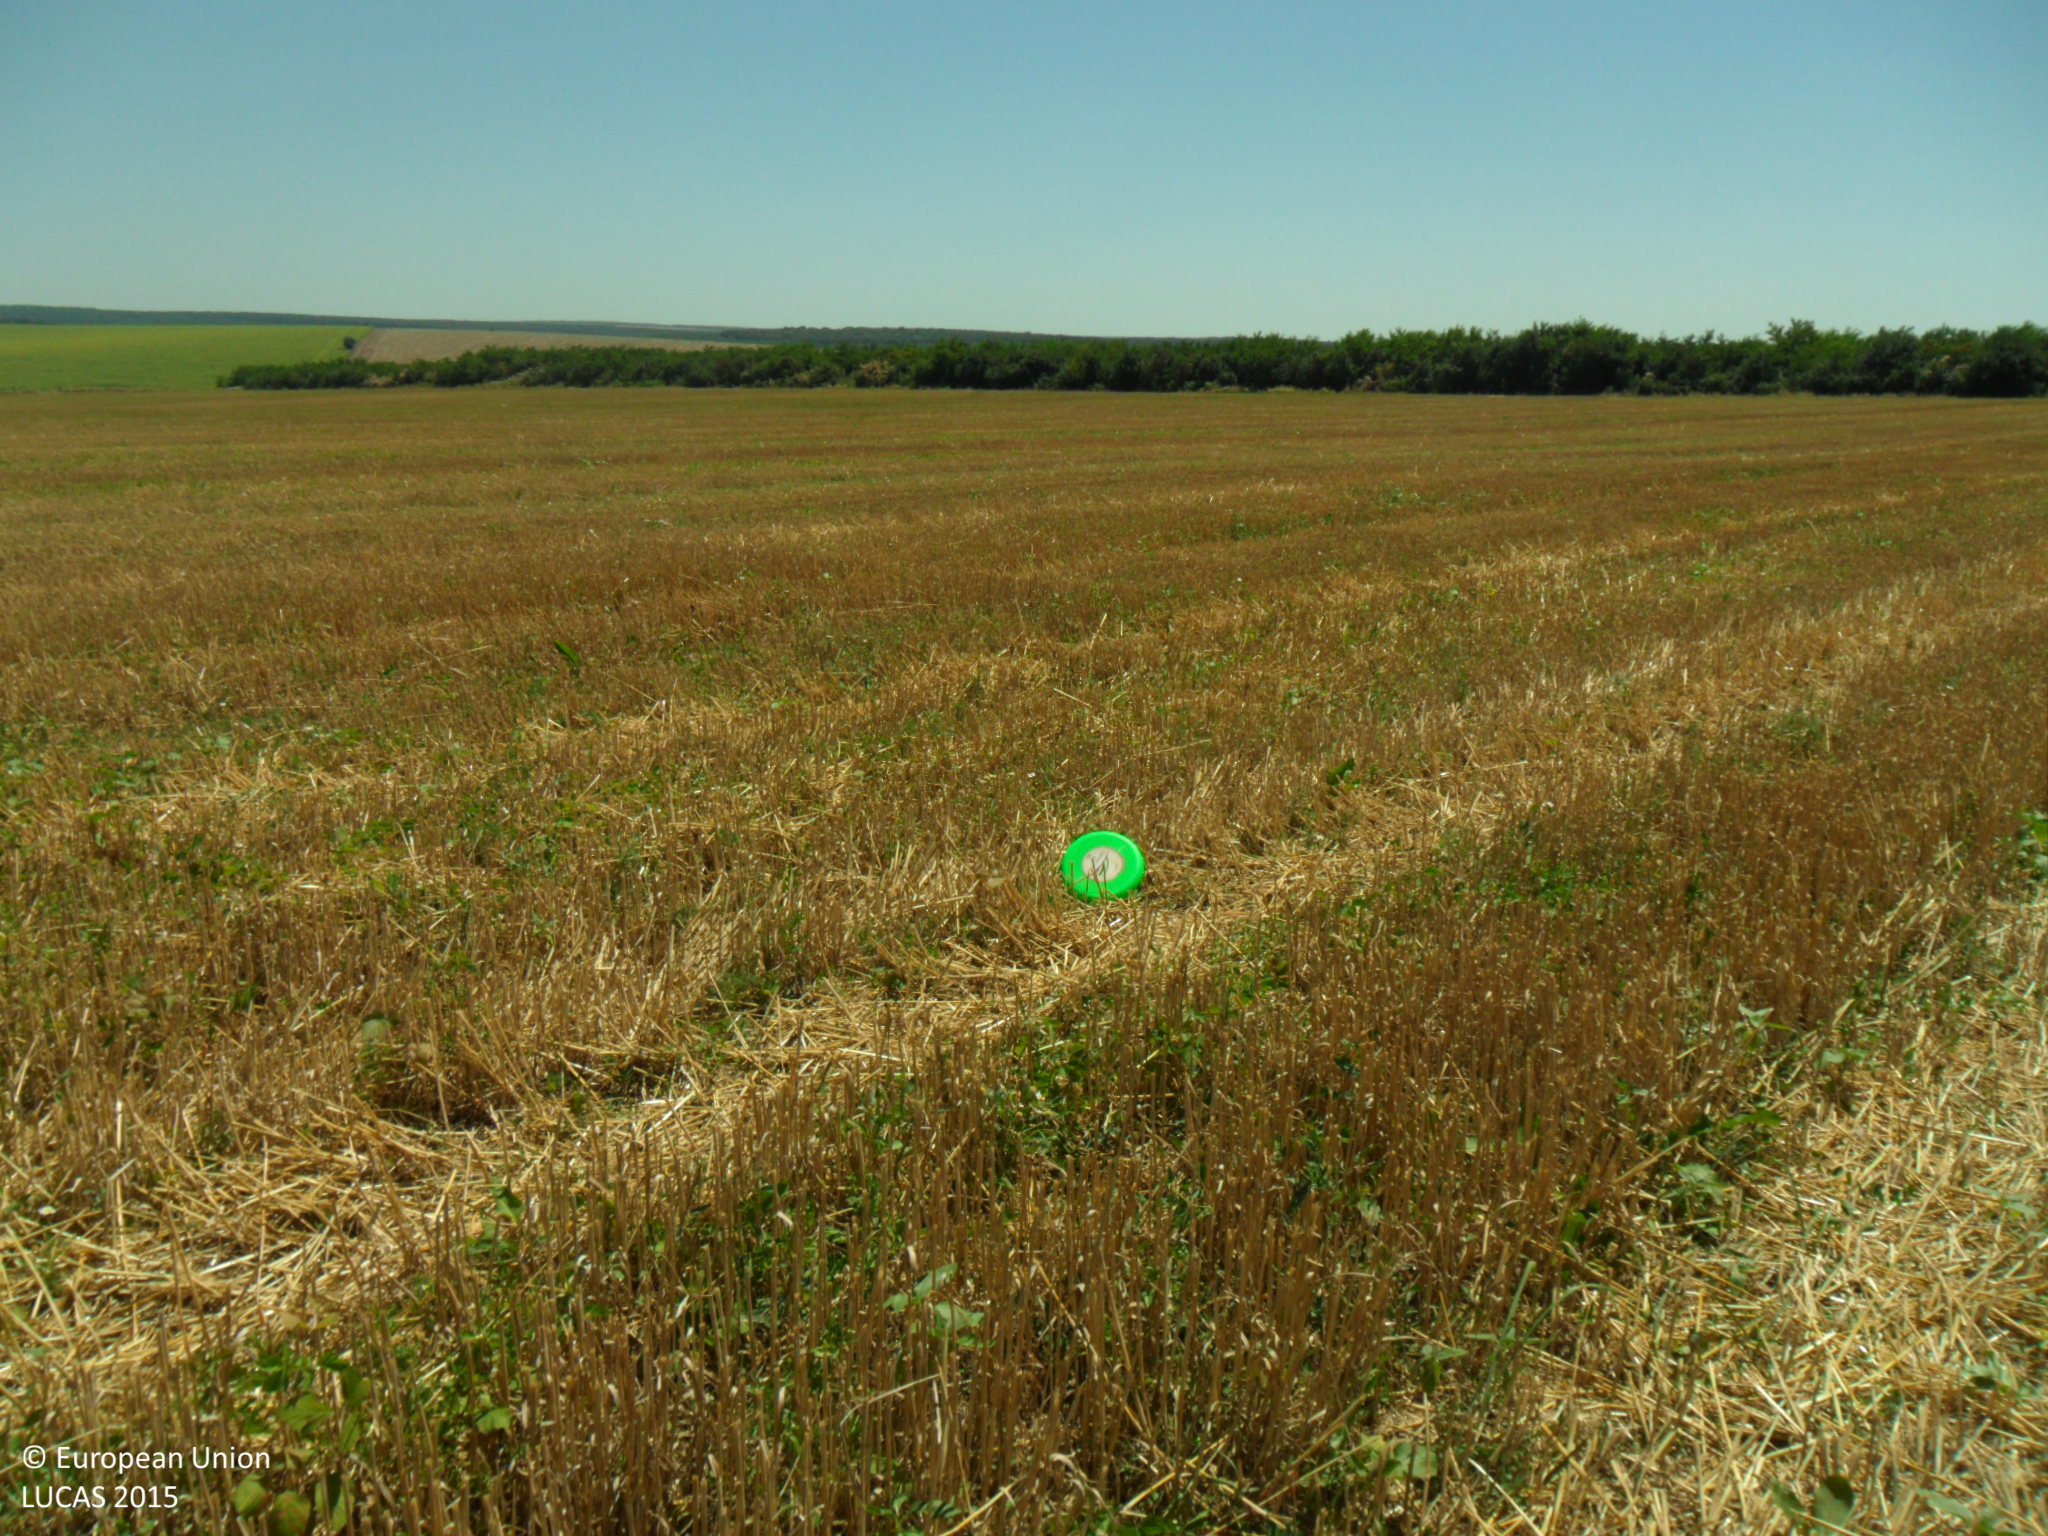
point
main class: Cropland
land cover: Common wheat
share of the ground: 50 - 75 %
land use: Agriculture (excluding fallow land and kitchen gardens)
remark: Harvested field
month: July
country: BG
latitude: 43.8025
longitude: 26.4265
